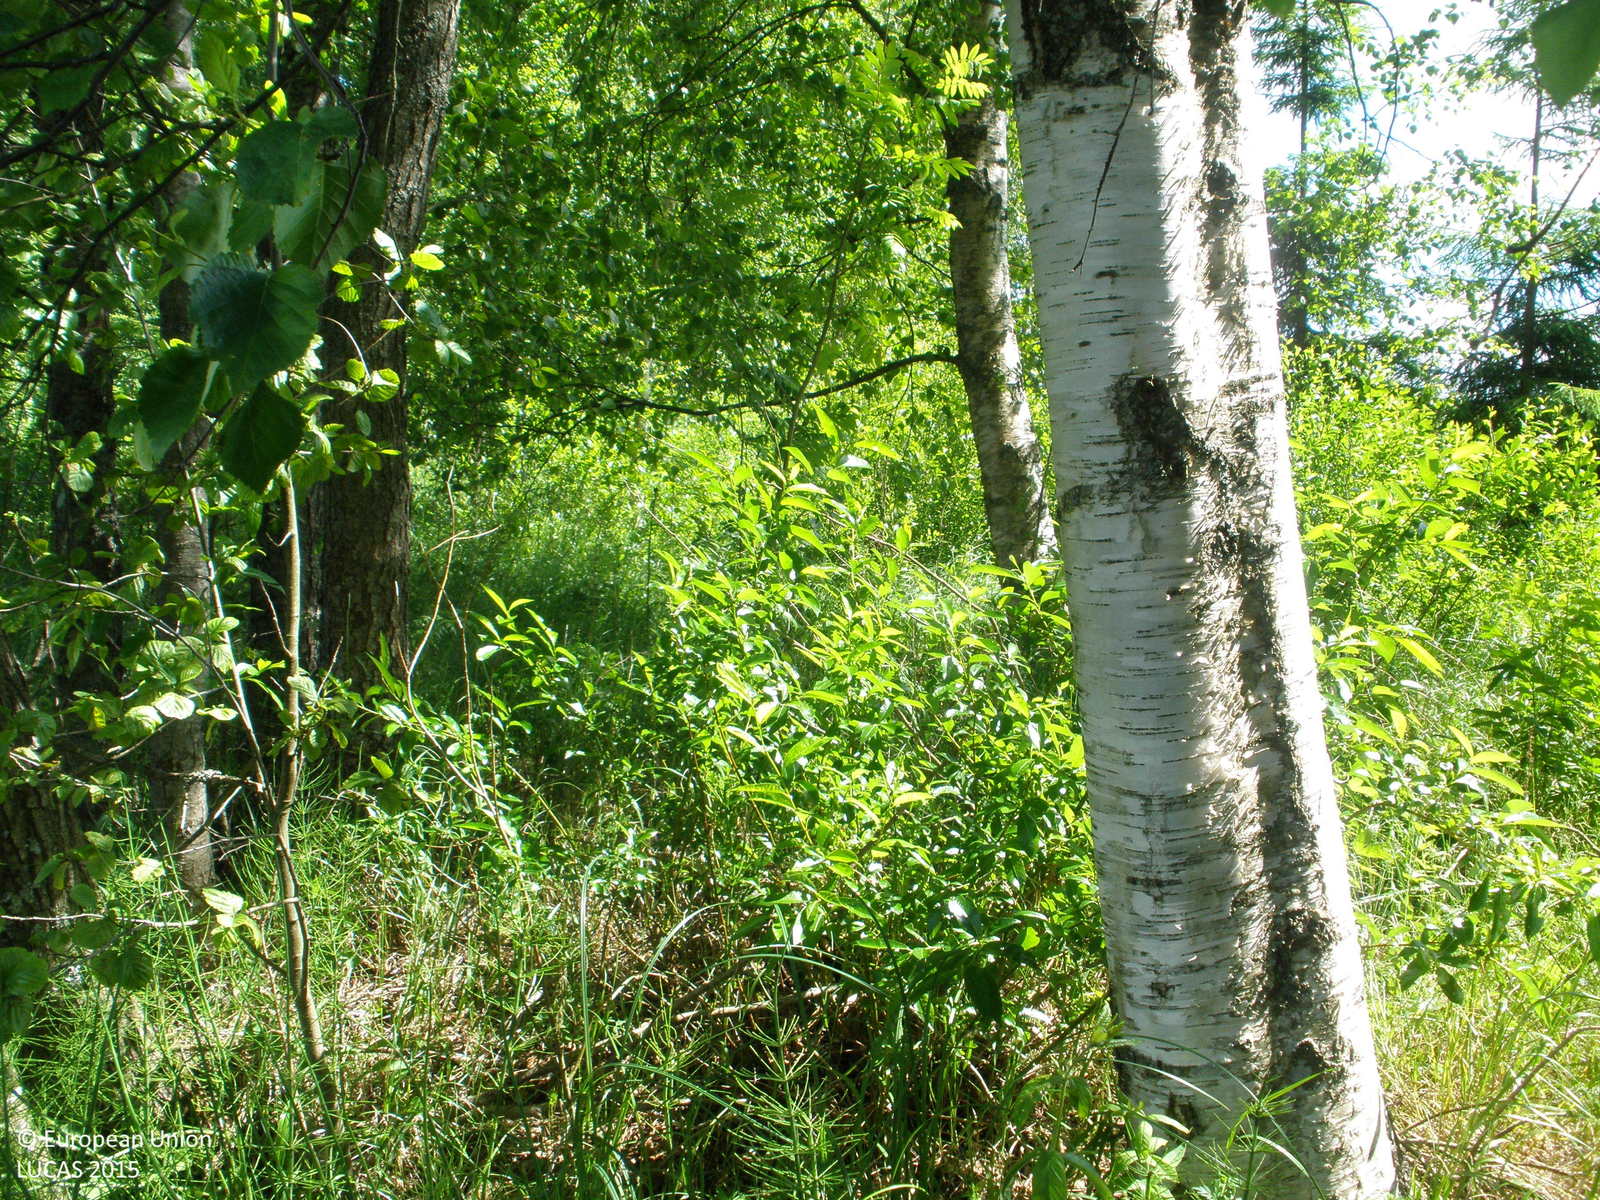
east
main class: Woodland
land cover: Broadleaved woodland
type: non-riverine alder, birch or aspen forest
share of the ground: > 75 %
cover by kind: broadleaved forest trees 80 %, herbaceous plants 20 %
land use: Forestry
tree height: > 5 m
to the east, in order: Broadleaved woodland; Tracks; Broadleaved woodland; Artificial constructions in urban areas; Other mixed woodland; Inland fresh water bodies
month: June
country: FI
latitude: 61.0399
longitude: 24.1472
